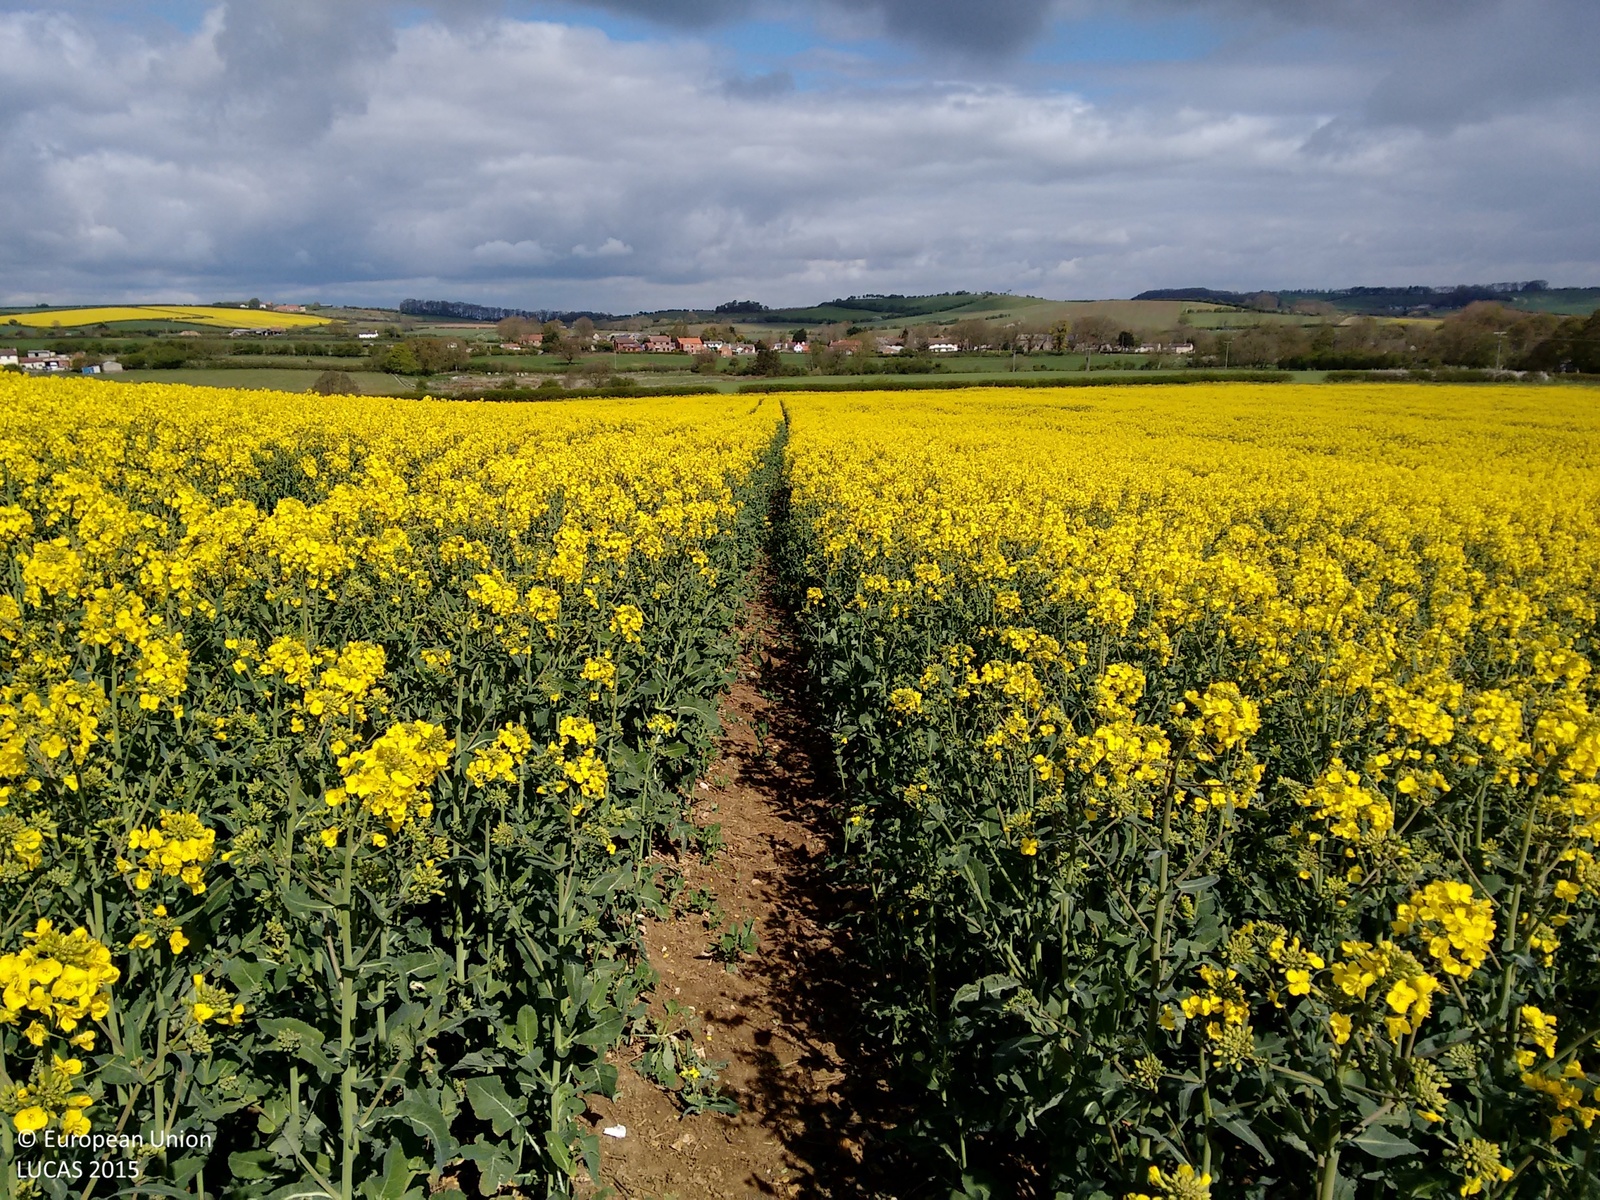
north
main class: Cropland
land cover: Rape and turnip rape
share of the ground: > 75 %
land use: Agriculture (excluding fallow land and kitchen gardens)
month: April
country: GB
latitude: 53.2538
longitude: -0.0600
